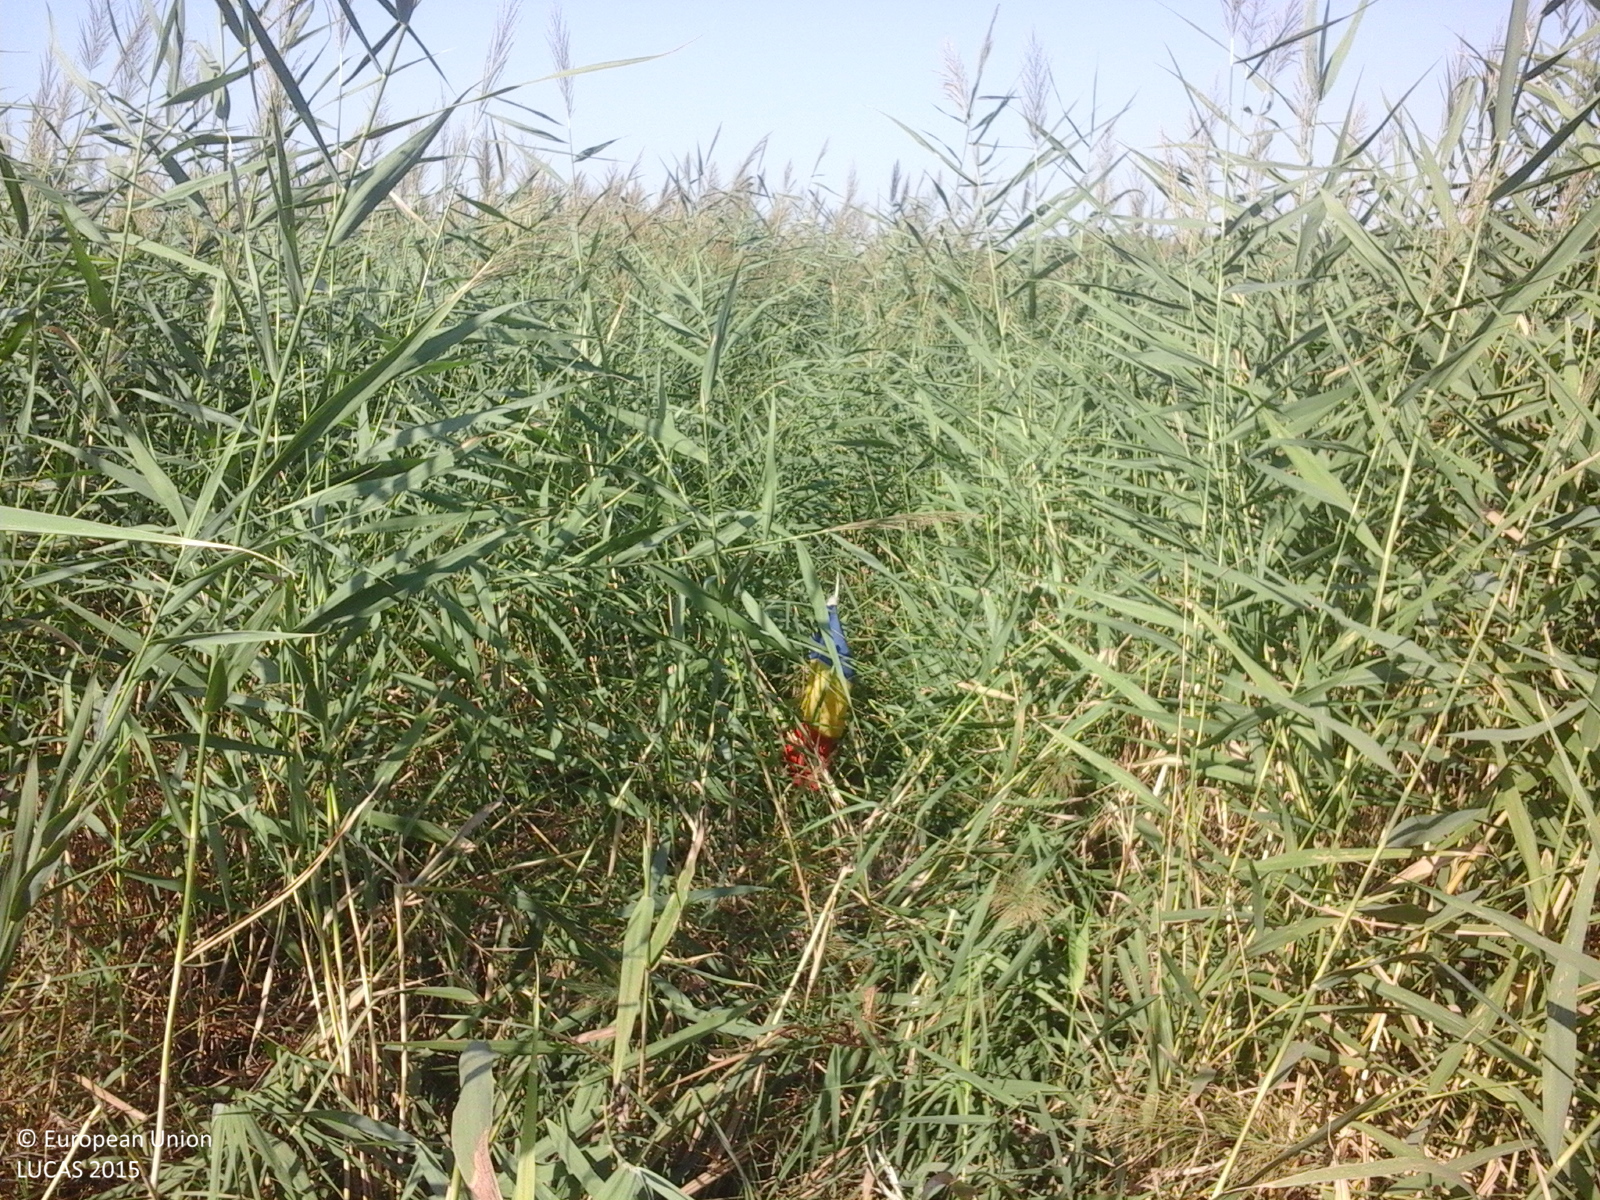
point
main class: Grassland
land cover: Spontaneously vegetated surfaces
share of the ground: > 75 %
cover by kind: herbaceous plants 100 %
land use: Semi-natural and natural areas not in use
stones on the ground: < 10 %
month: August
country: RO
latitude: 43.9627
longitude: 22.8889
